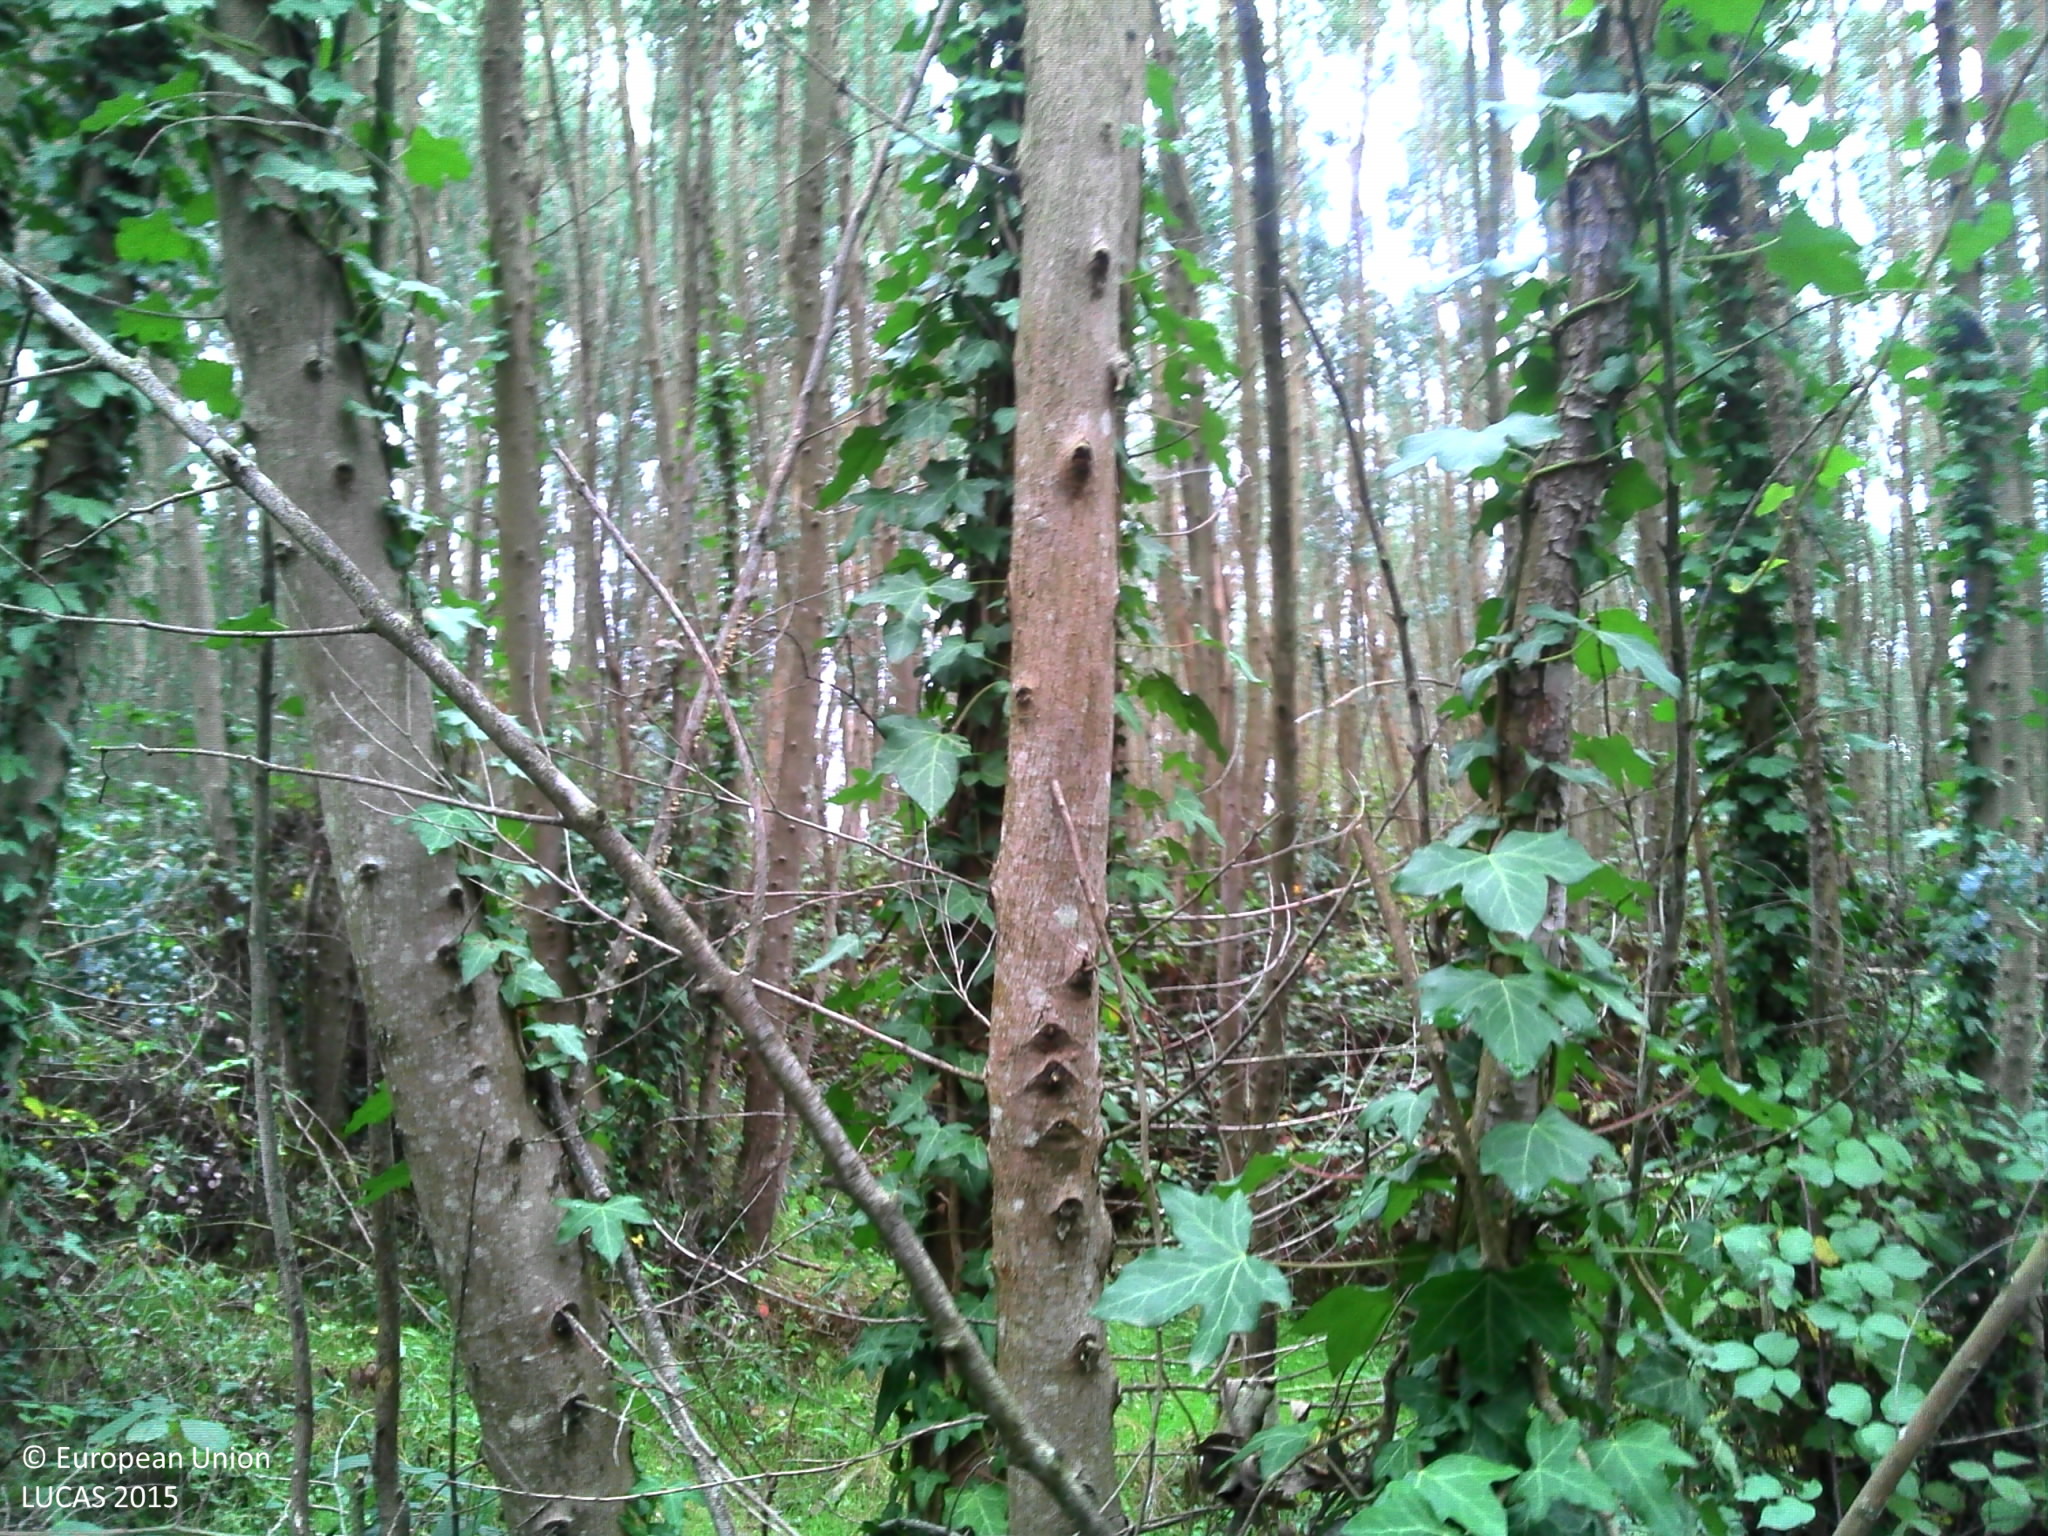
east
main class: Woodland
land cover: Broadleaved woodland
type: exotic forest
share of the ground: 50 - 75 %
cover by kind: broadleaved forest trees 60 %, shrubs 30 %, herbaceous plants 5 %, lichens and mosses 5 %
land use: Forestry
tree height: > 5 m
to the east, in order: Broadleaved woodland; Shrubland without tree cover; Broadleaved woodland; Tracks; Broadleaved woodland
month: September
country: FR
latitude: 43.3813
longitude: -0.4878
